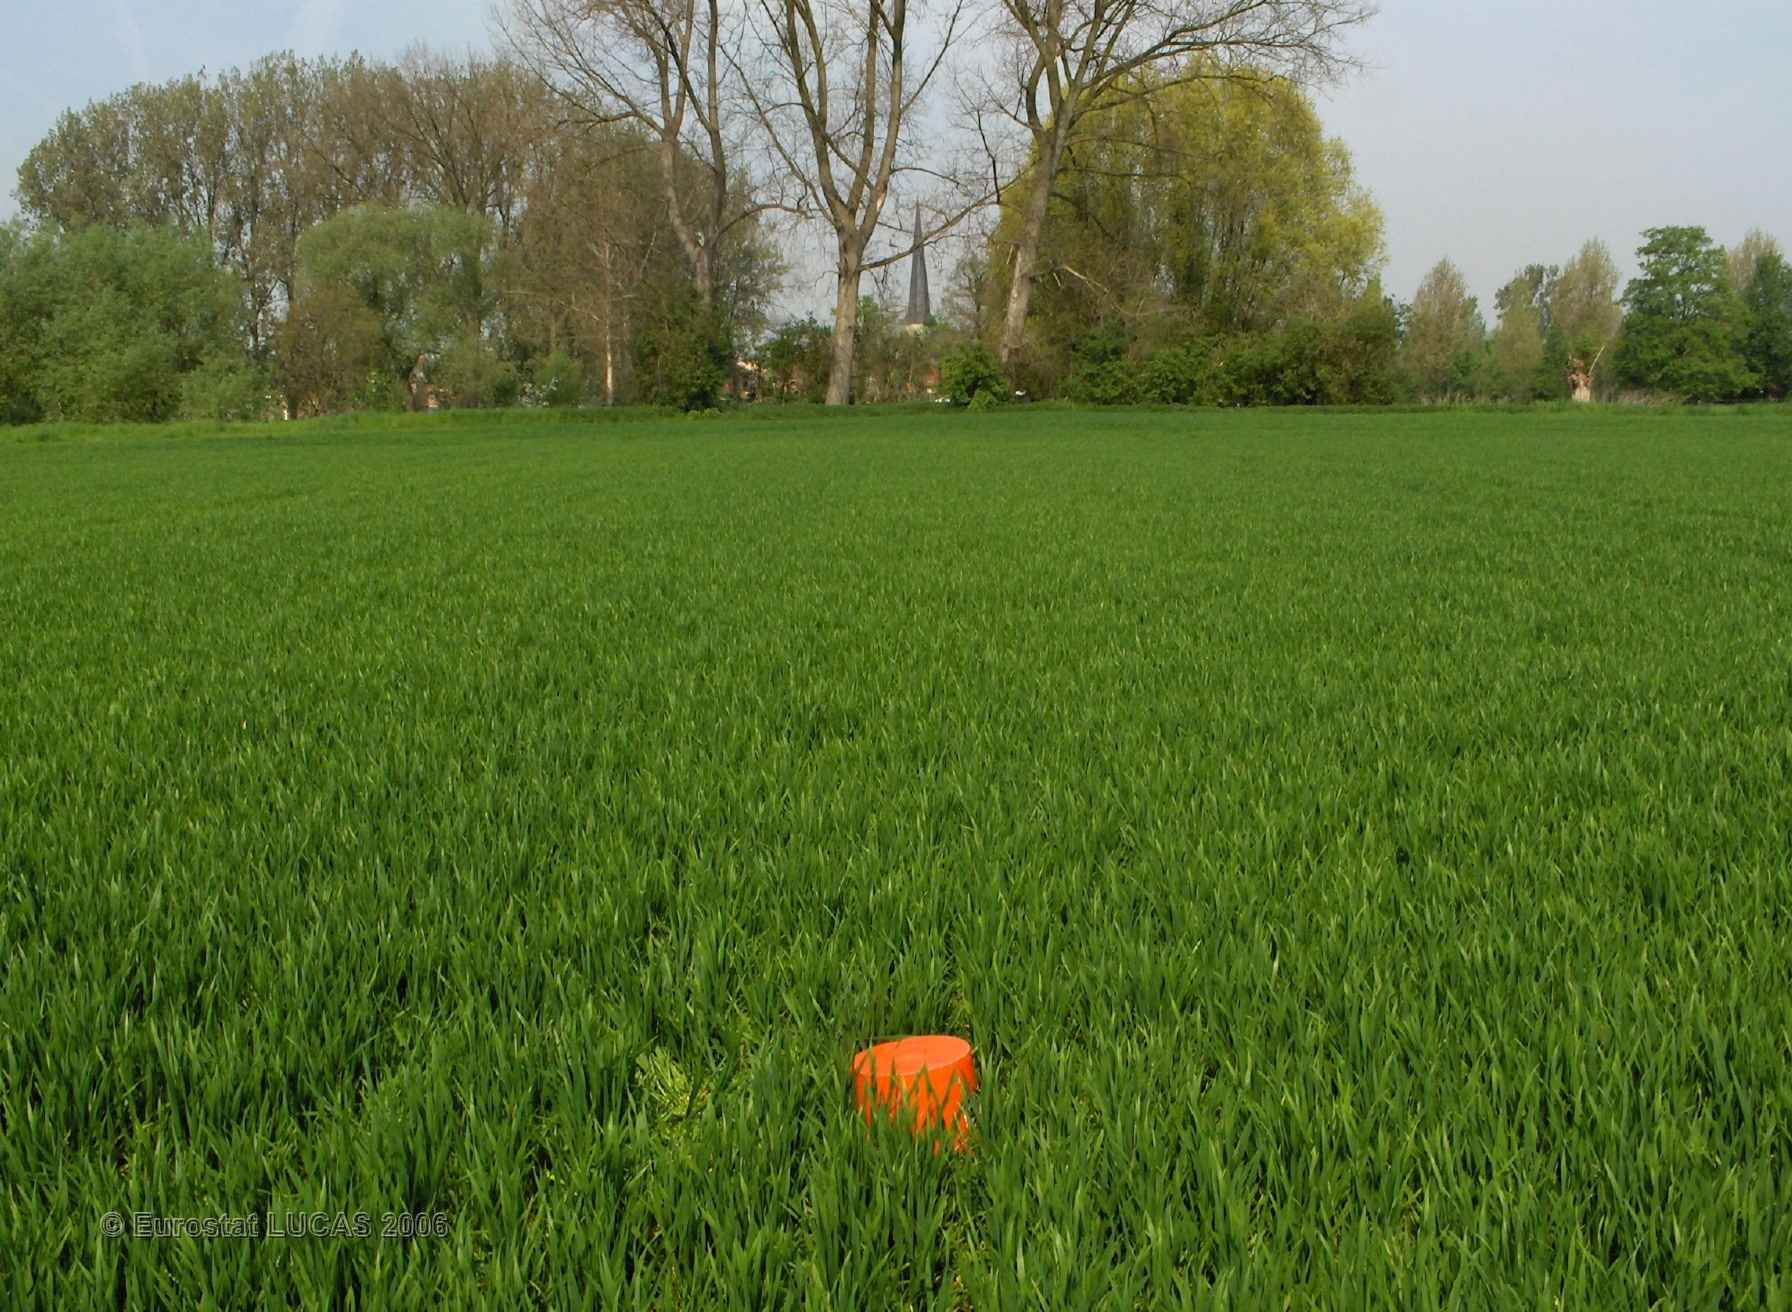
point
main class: Cropland
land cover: Common wheat
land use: Agriculture (excluding fallow land and kitchen gardens)
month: May
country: BE
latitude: 50.9699
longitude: 4.4846
